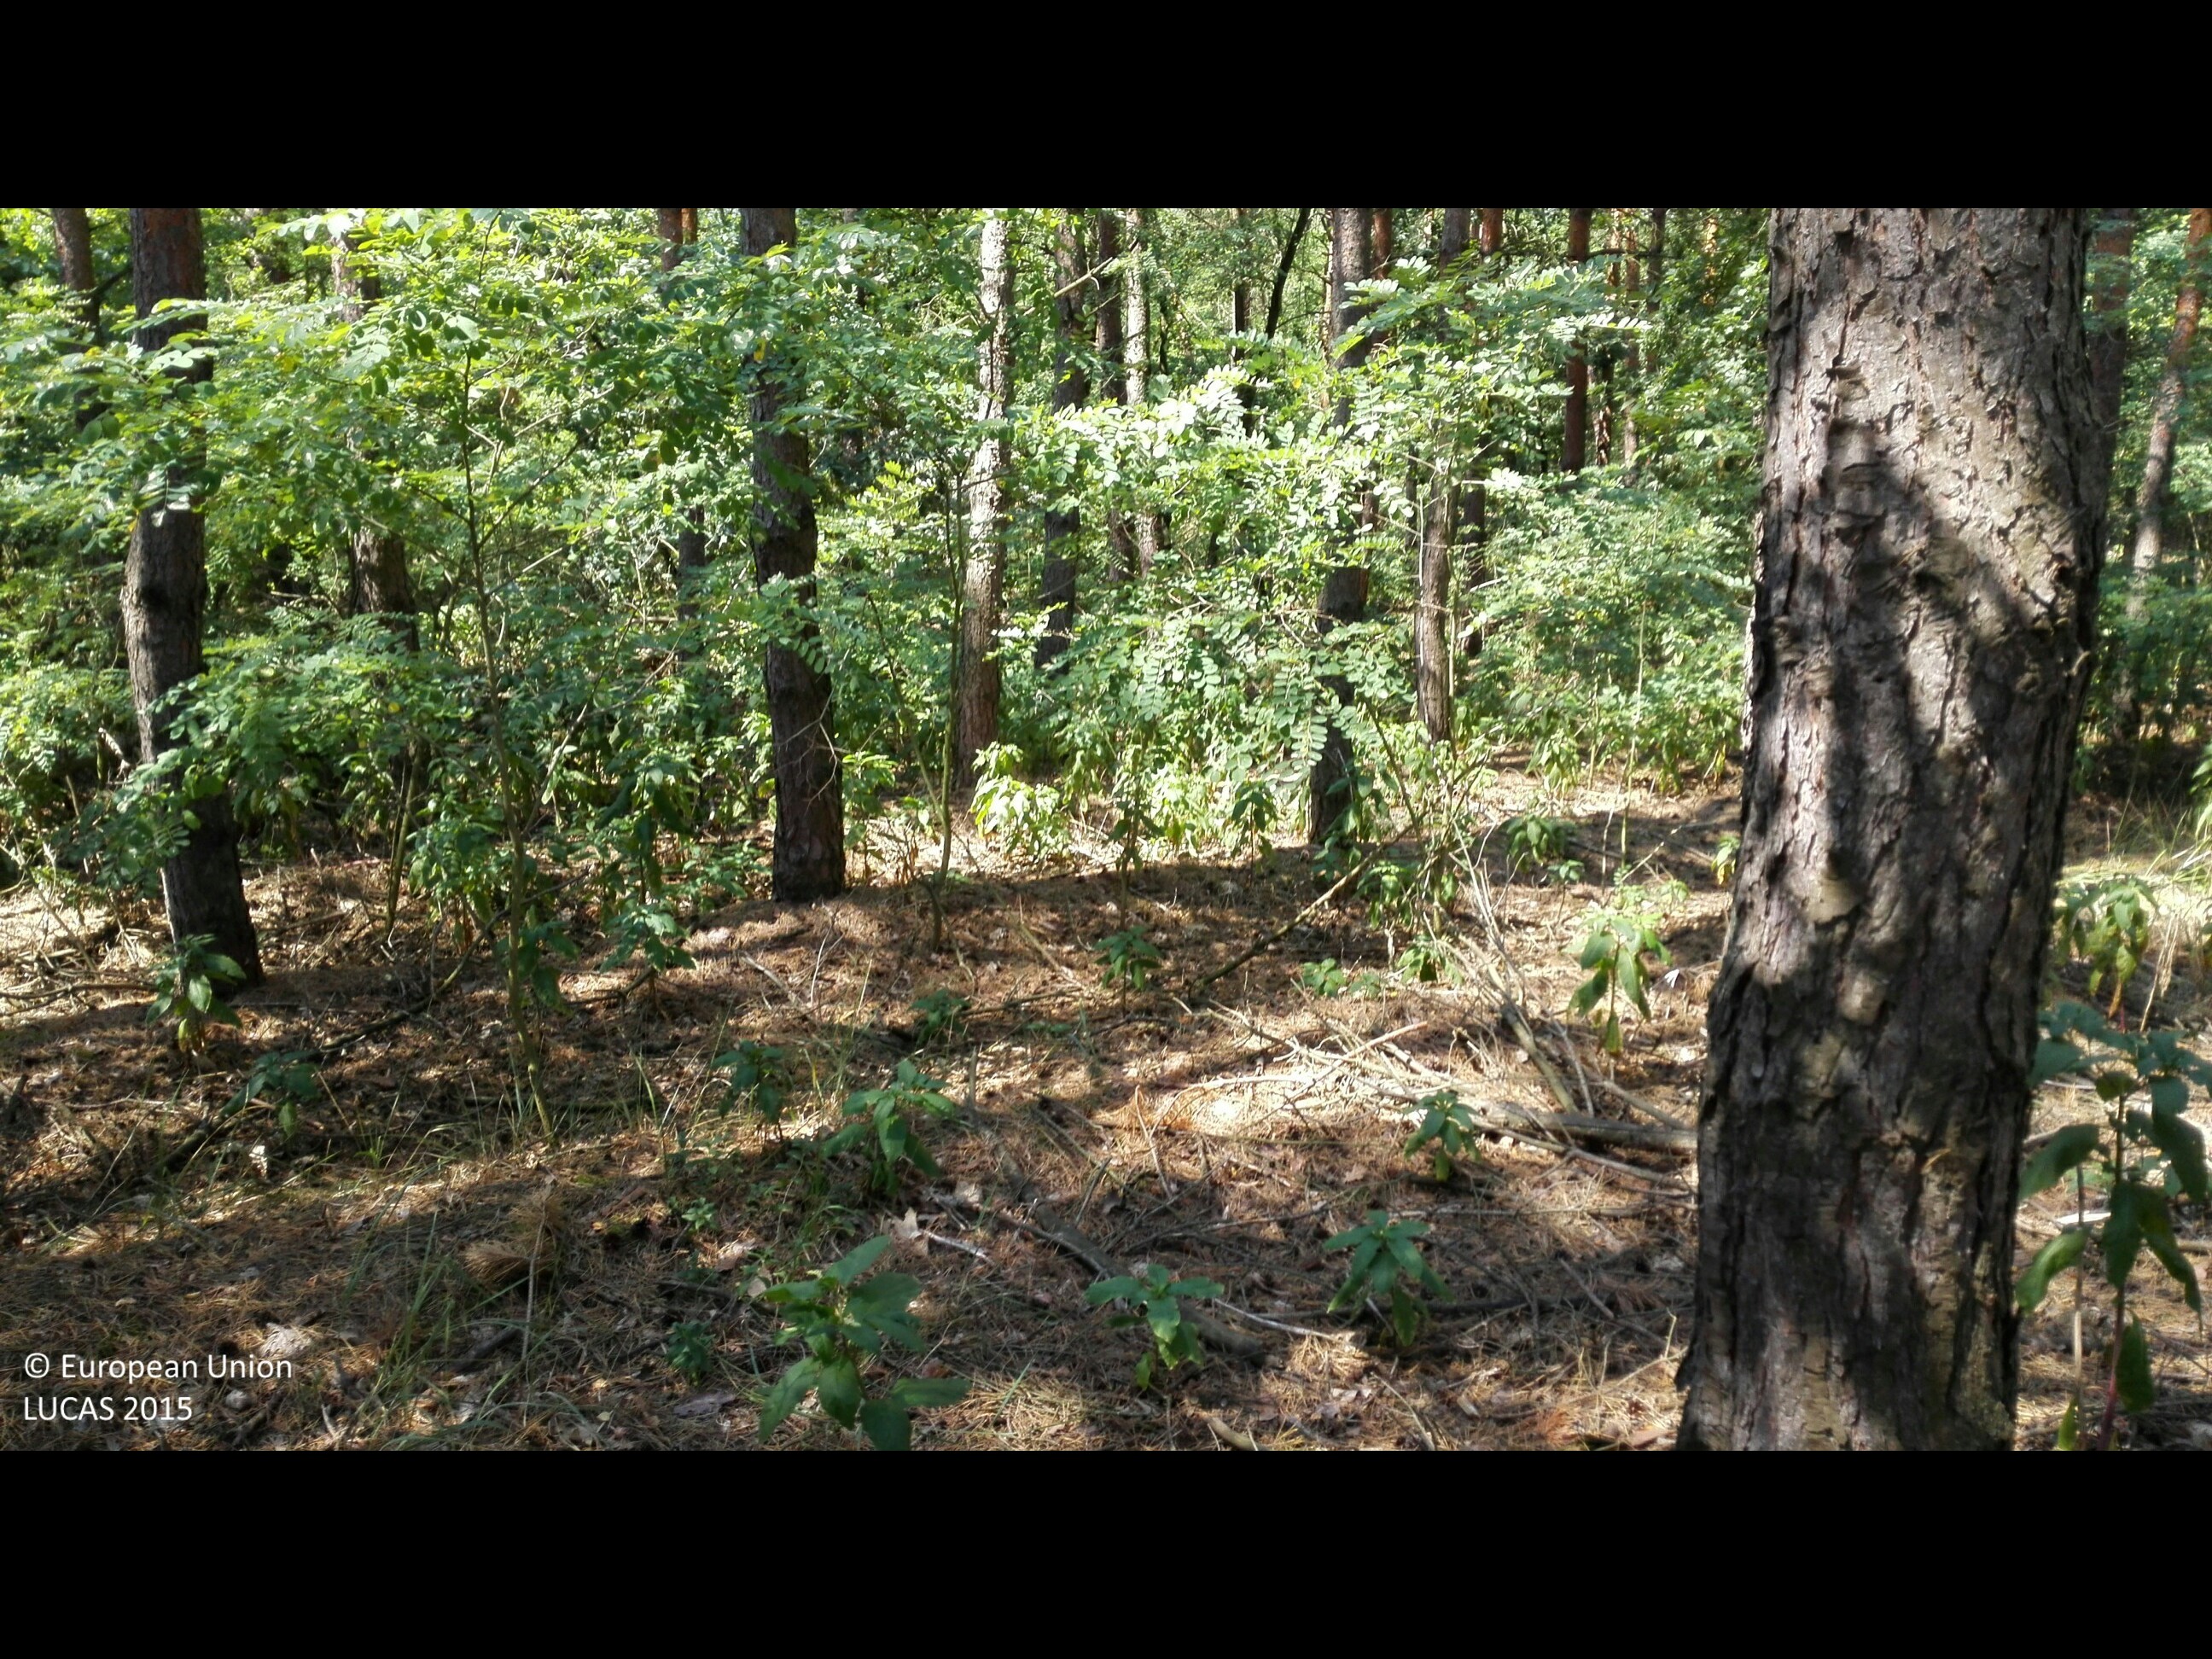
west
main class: Woodland
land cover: Pine dominated coniferous woodland
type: hemiboreal forest and nemoral coniferous forest and mixed broadleaved-coniferous forest
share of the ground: > 75 %
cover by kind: coniferous forest trees 90 %, shrubs 10 %
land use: Forestry
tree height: > 5 m
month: August
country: HU
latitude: 47.4941
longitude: 21.8209
